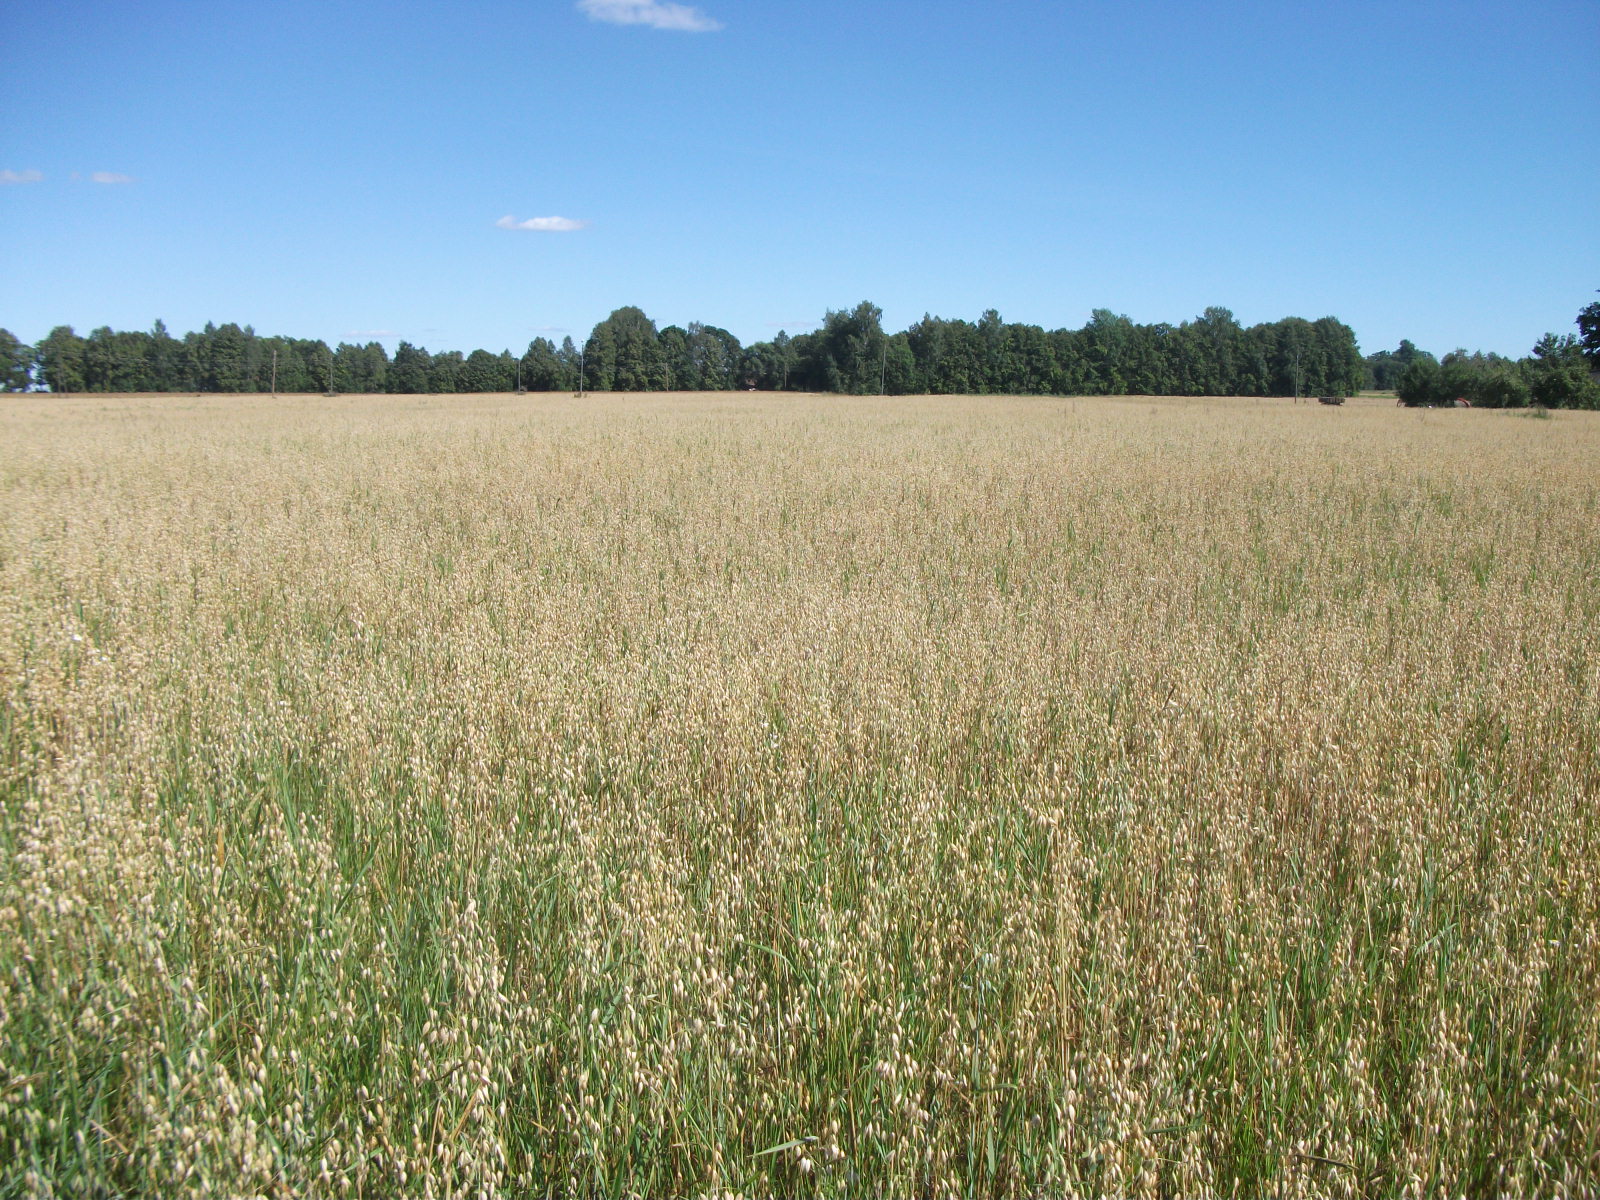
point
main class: Cropland
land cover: Oats
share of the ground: > 75 %
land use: Agriculture (excluding fallow land and kitchen gardens)
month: August
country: LV
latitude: 56.6673
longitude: 26.1104
